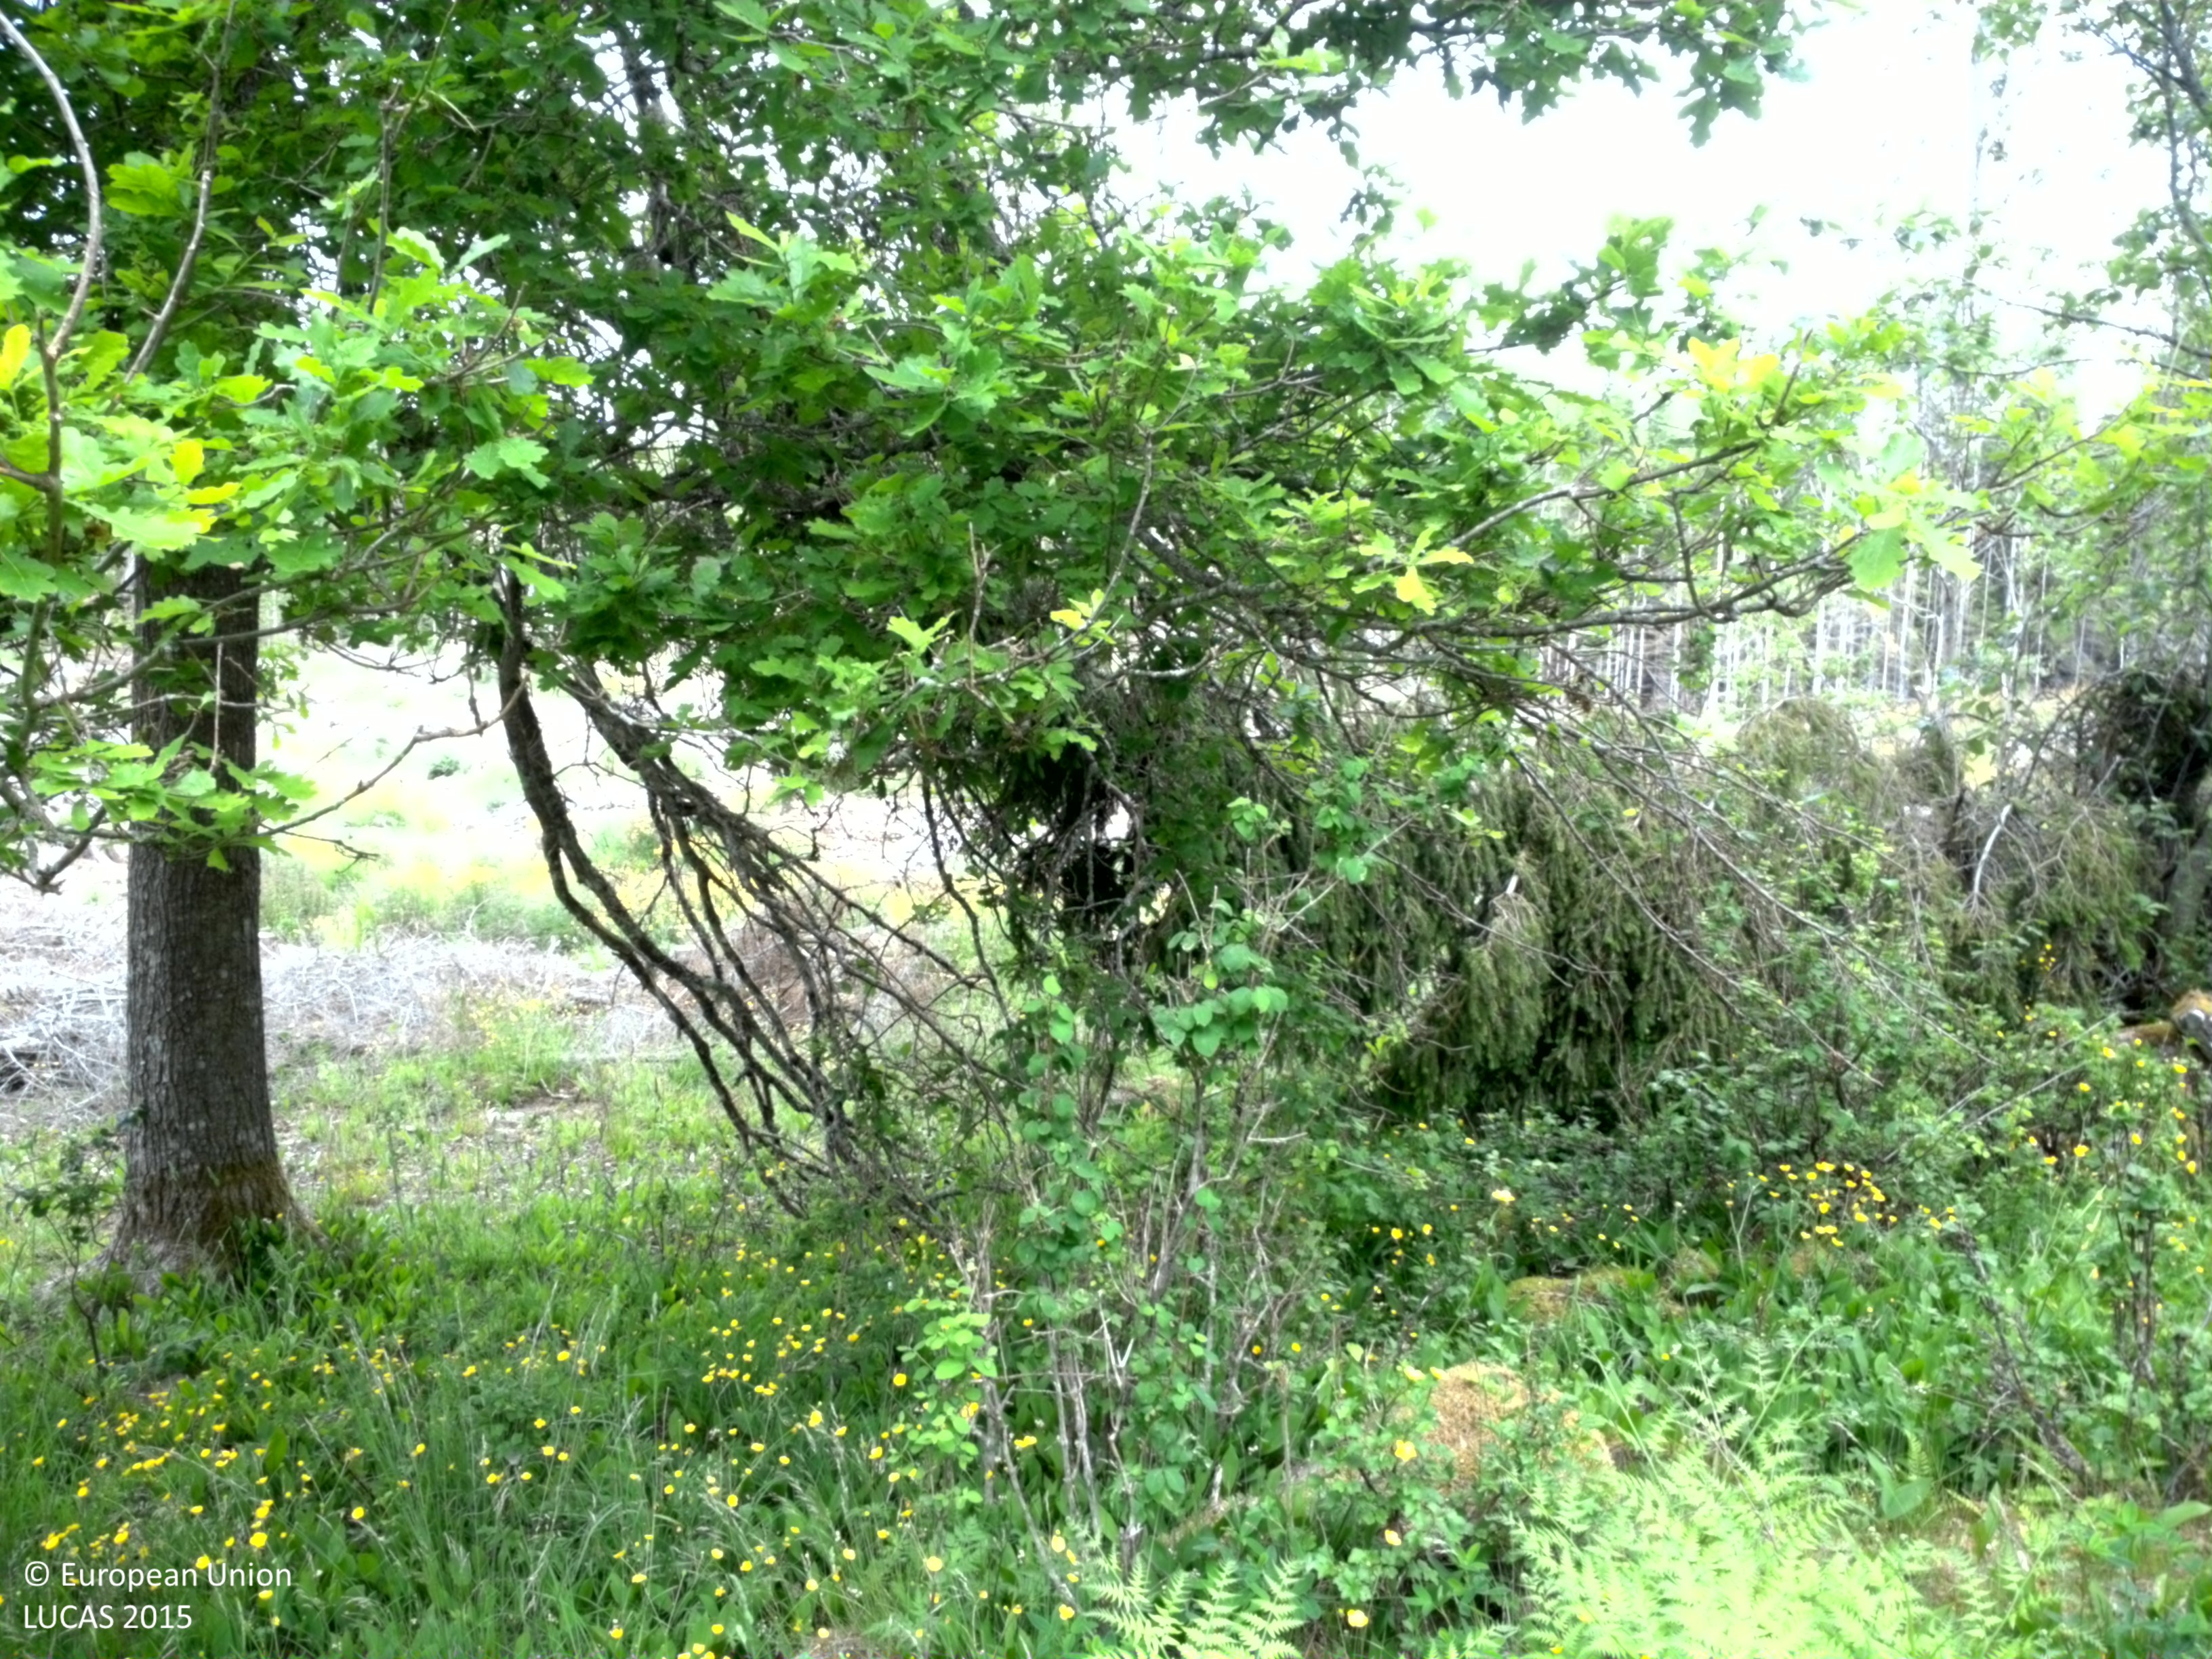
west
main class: Woodland
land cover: Broadleaved woodland
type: hemiboreal forest and nemoral coniferous forest and mixed broadleaved-coniferous forest
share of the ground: 10 - 25 %
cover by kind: herbaceous plants 50 %, broadleaved forest trees 20 %, lichens and mosses 15 %, shrubs 10 %, coniferous forest trees 5 %
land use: Forestry
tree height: > 5 m
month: June
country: SE
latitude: 60.0159
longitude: 18.7711
